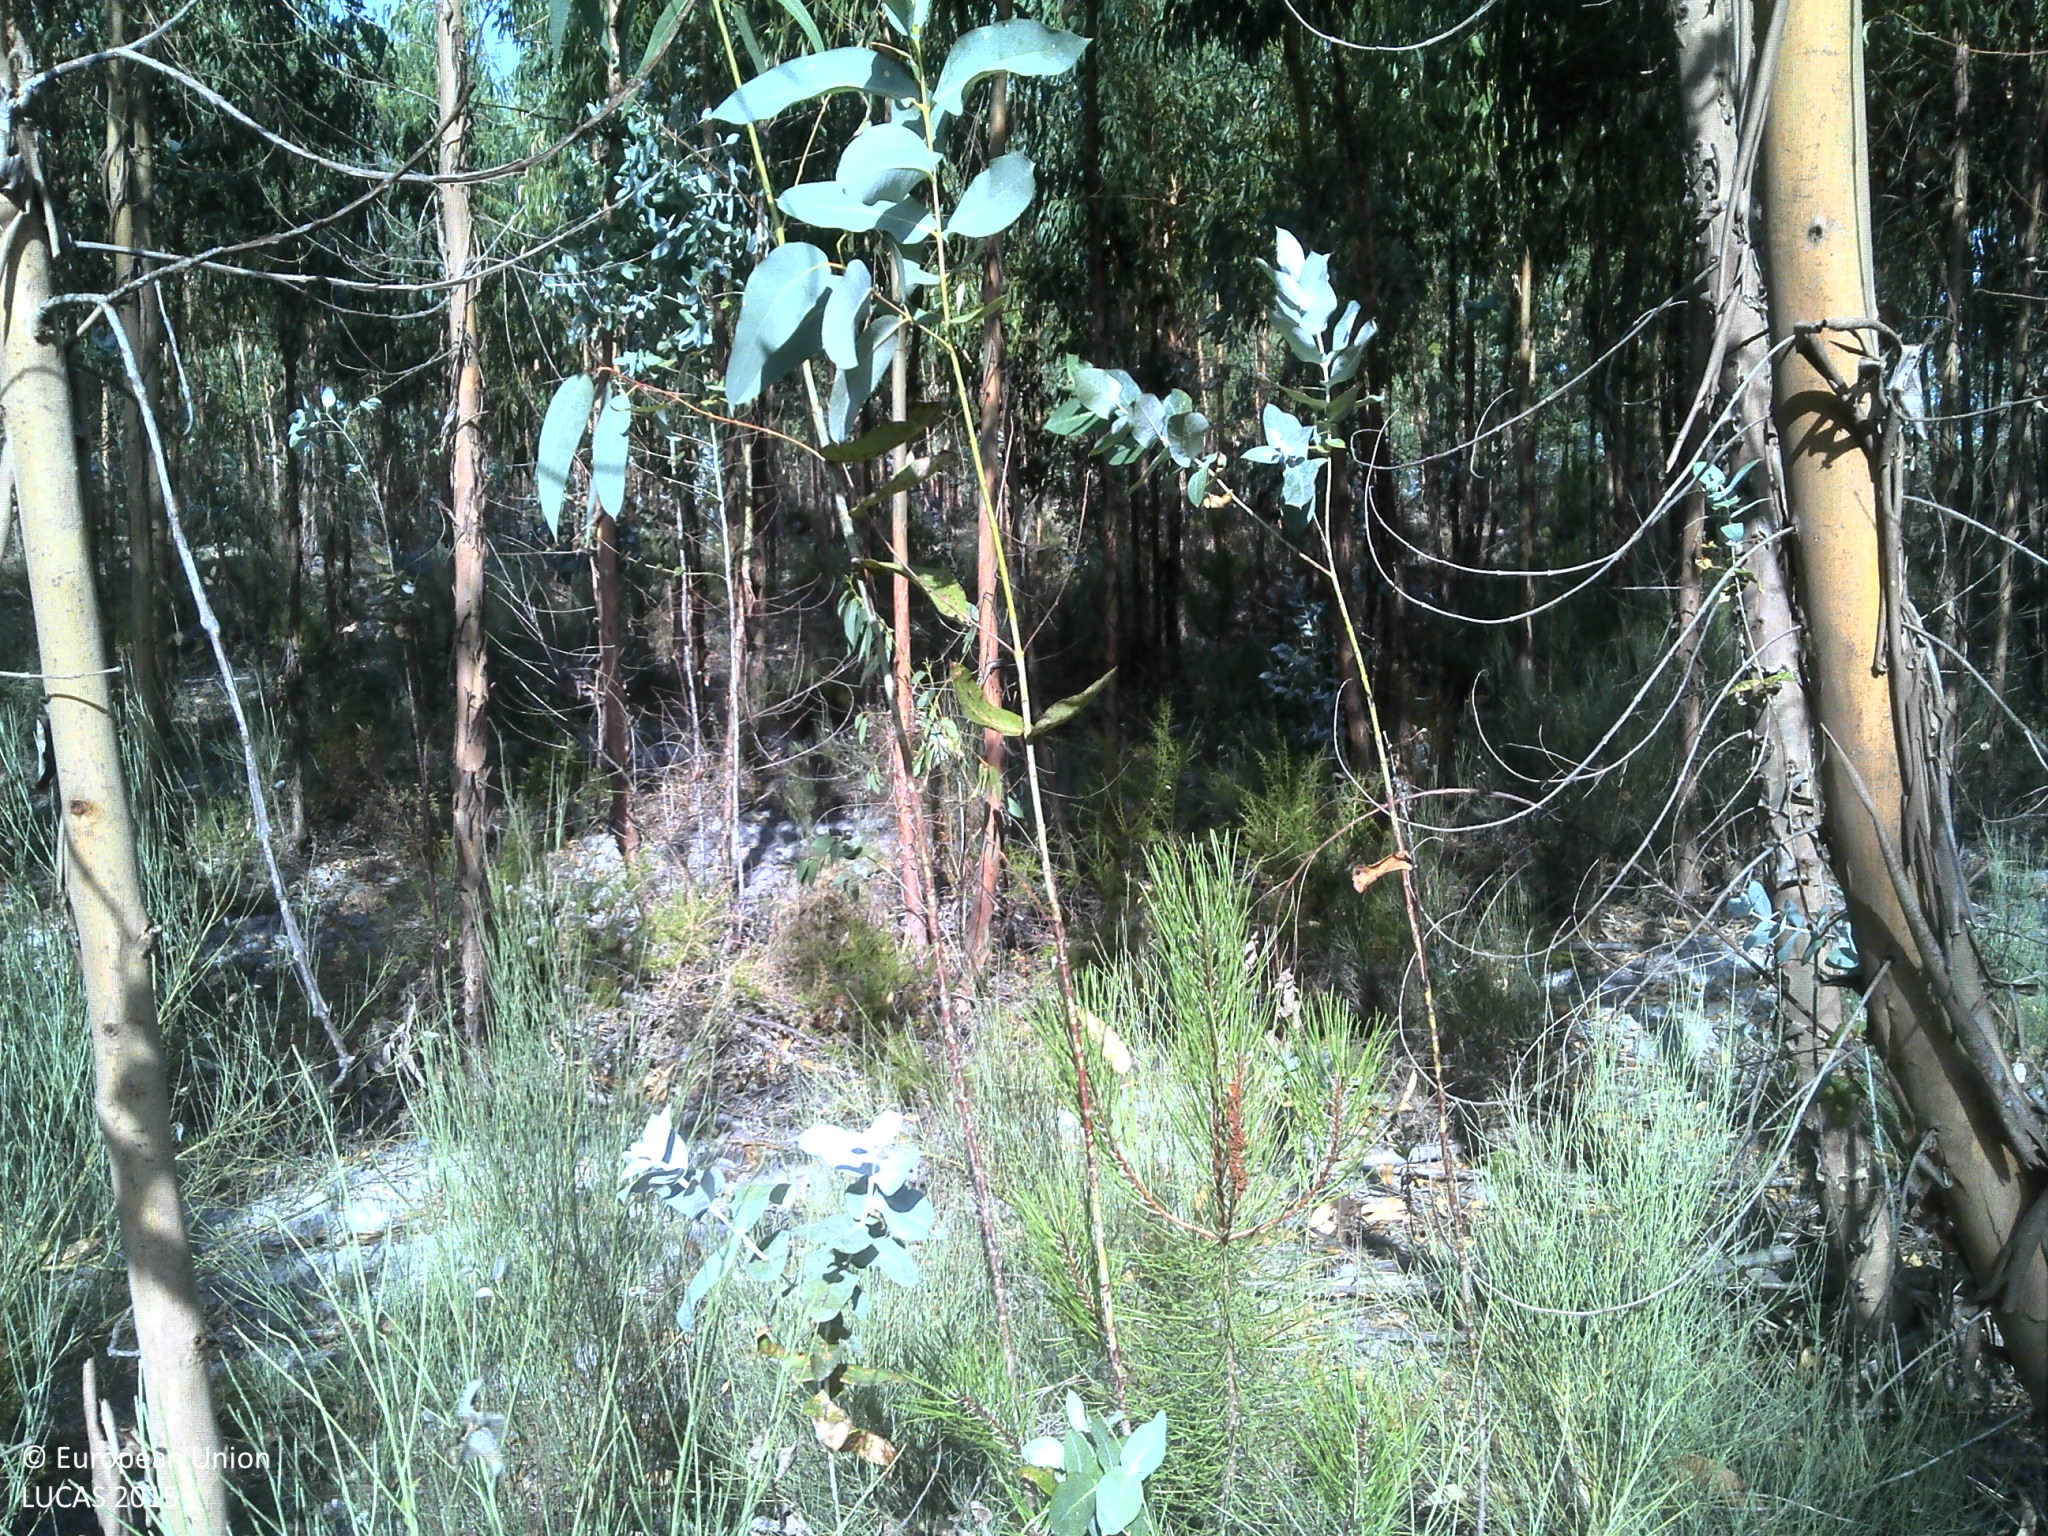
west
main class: Woodland
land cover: Broadleaved woodland
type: exotic forest
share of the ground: 50 - 75 %
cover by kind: broadleaved forest trees 60 %, unconsolidated bare surface 30 %, shrubs 10 %
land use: Forestry
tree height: > 5 m
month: July
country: PT
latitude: 39.1564
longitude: -8.3102
